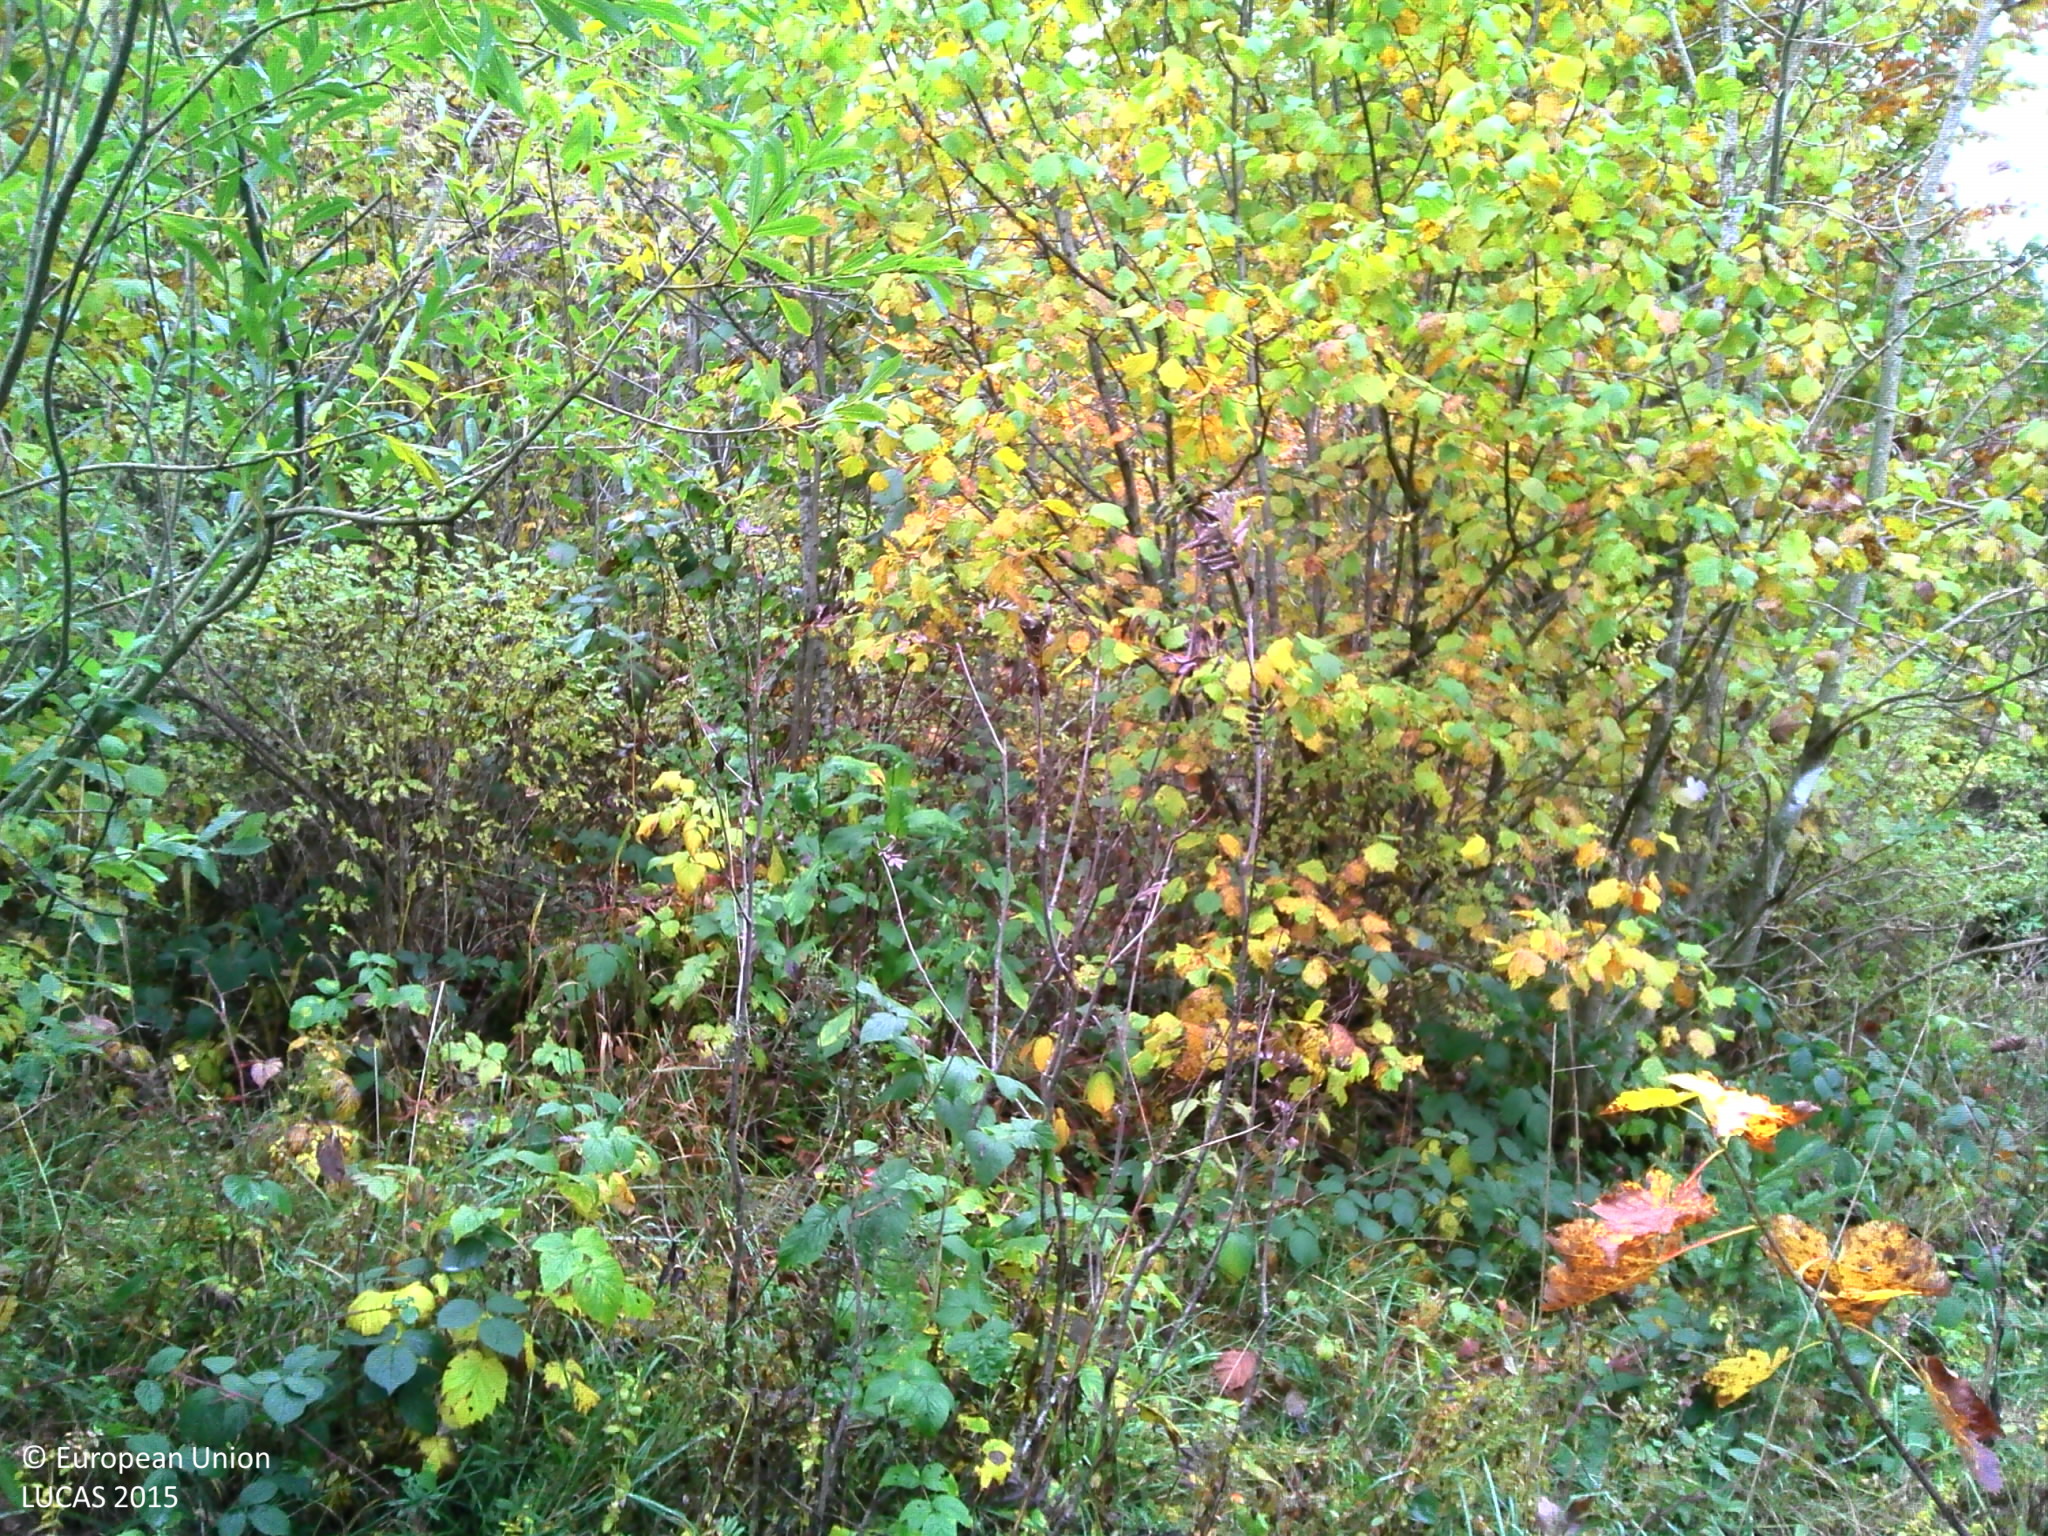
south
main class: Woodland
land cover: Spruce dominated mixed woodland
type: hemiboreal forest and nemoral coniferous forest and mixed broadleaved-coniferous forest
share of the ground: > 75 %
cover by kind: coniferous forest trees 40 %, broadleaved forest trees 40 %, shrubs 20 %
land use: Semi-natural and natural areas not in use
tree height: < 5 m
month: October
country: FR
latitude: 46.8493
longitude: 6.3960
